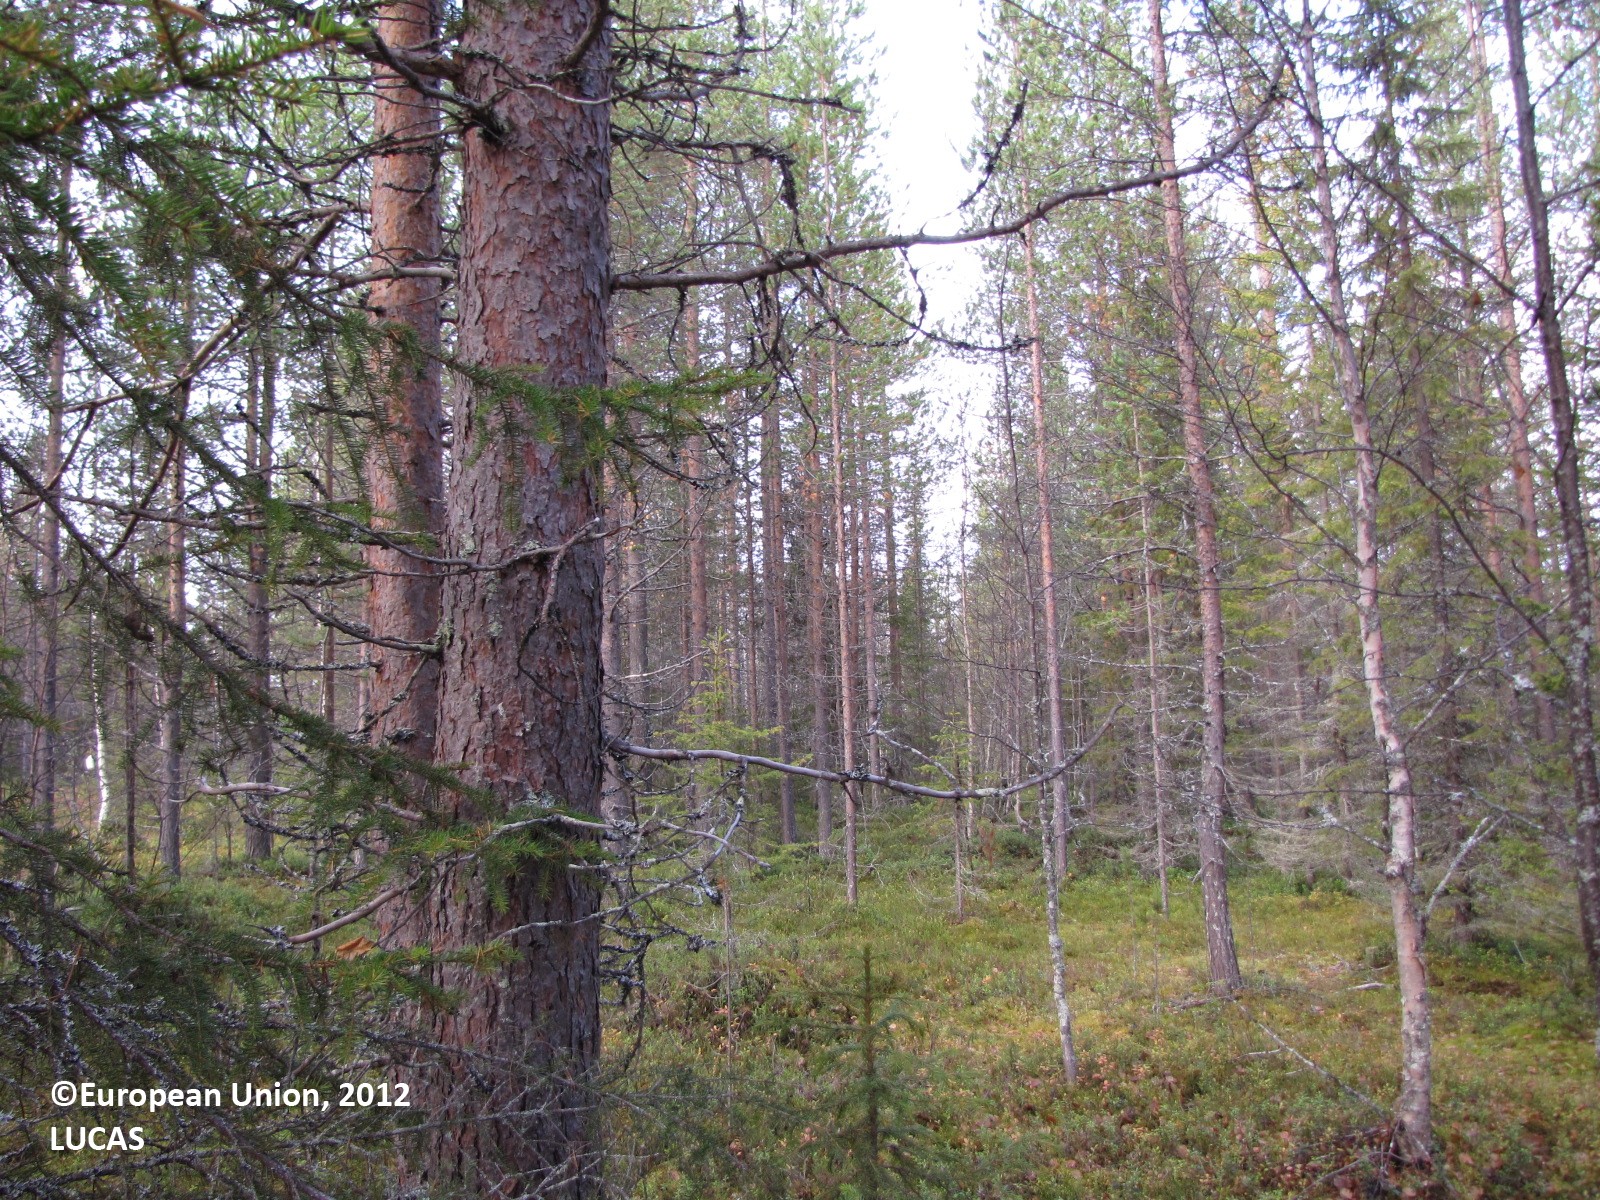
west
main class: Woodland
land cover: Pine dominated coniferous woodland
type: boreal forest
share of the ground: 25 - 50 %
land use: Forestry
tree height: > 5 m
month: September
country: FI
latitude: 67.7322
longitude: 25.1978
